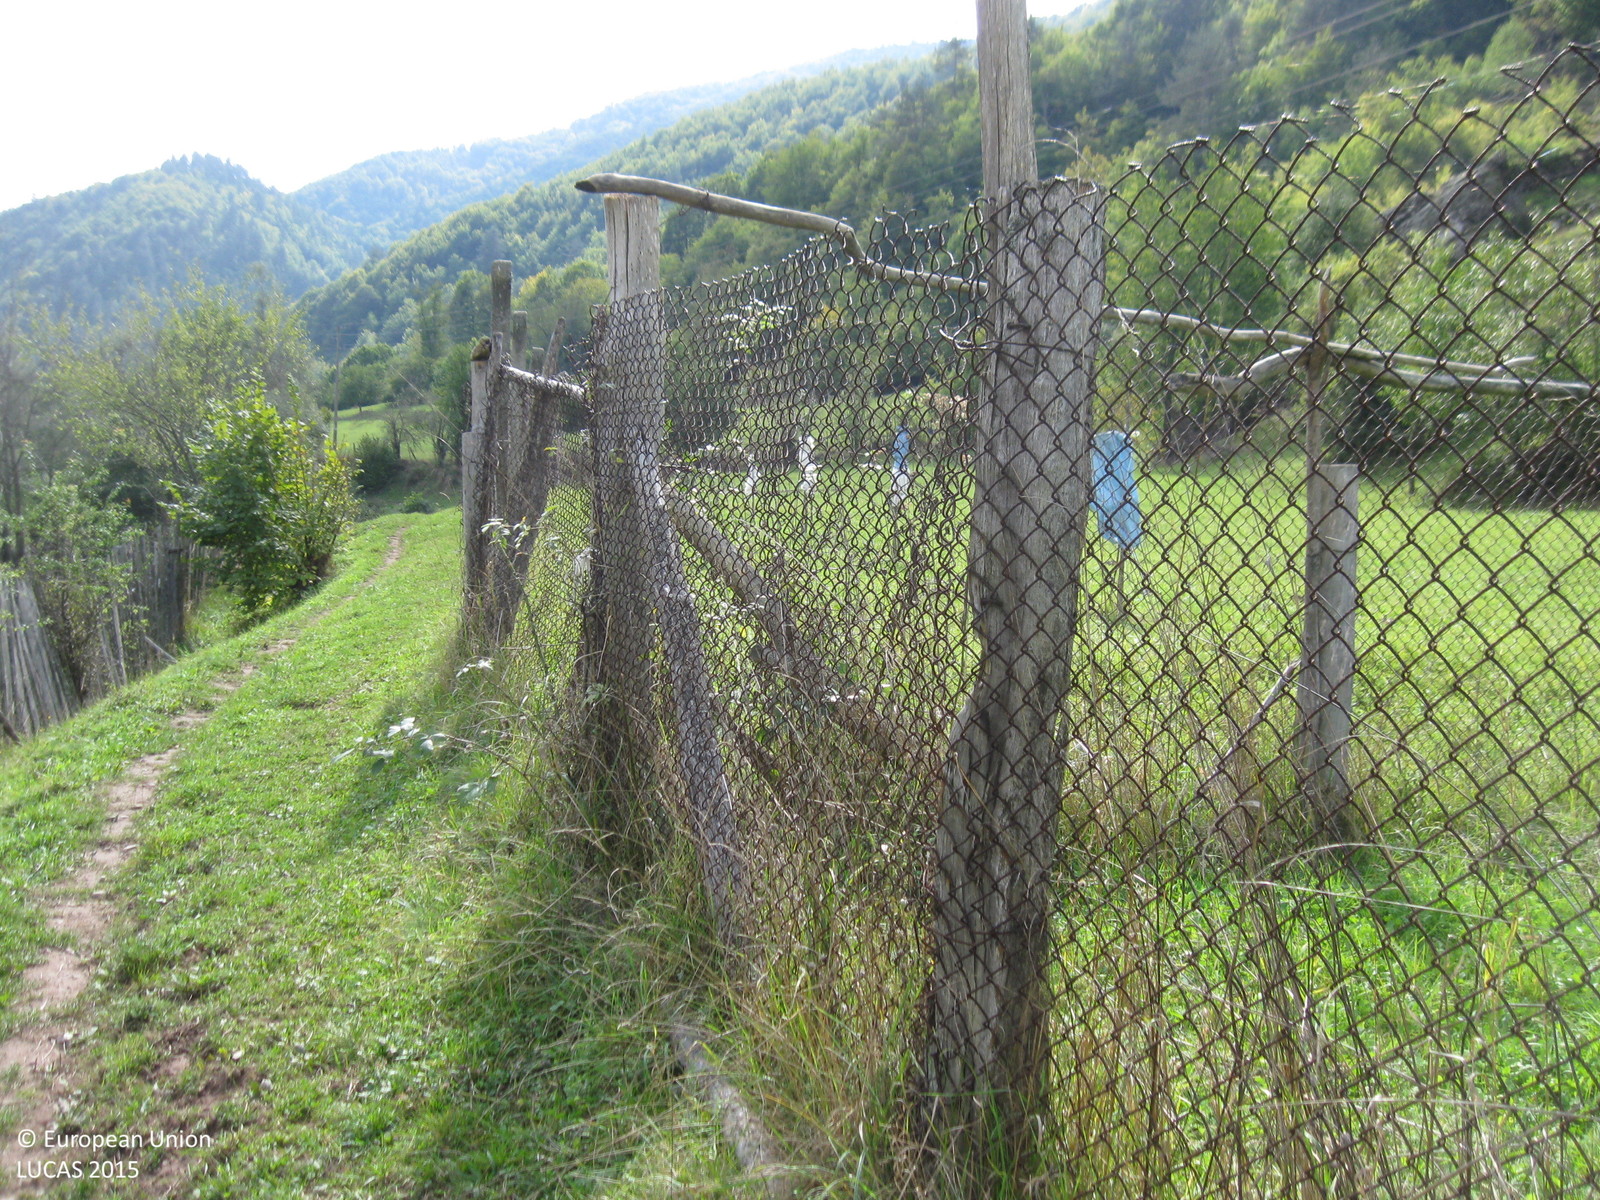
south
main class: Woodland
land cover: Pine dominated mixed woodland
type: mountainous beech forest
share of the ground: > 75 %
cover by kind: coniferous forest trees 50 %, broadleaved forest trees 45 %, shrubs 5 %
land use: Forestry
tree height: > 5 m
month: October
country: BG
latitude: 41.8207
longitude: 24.8943
